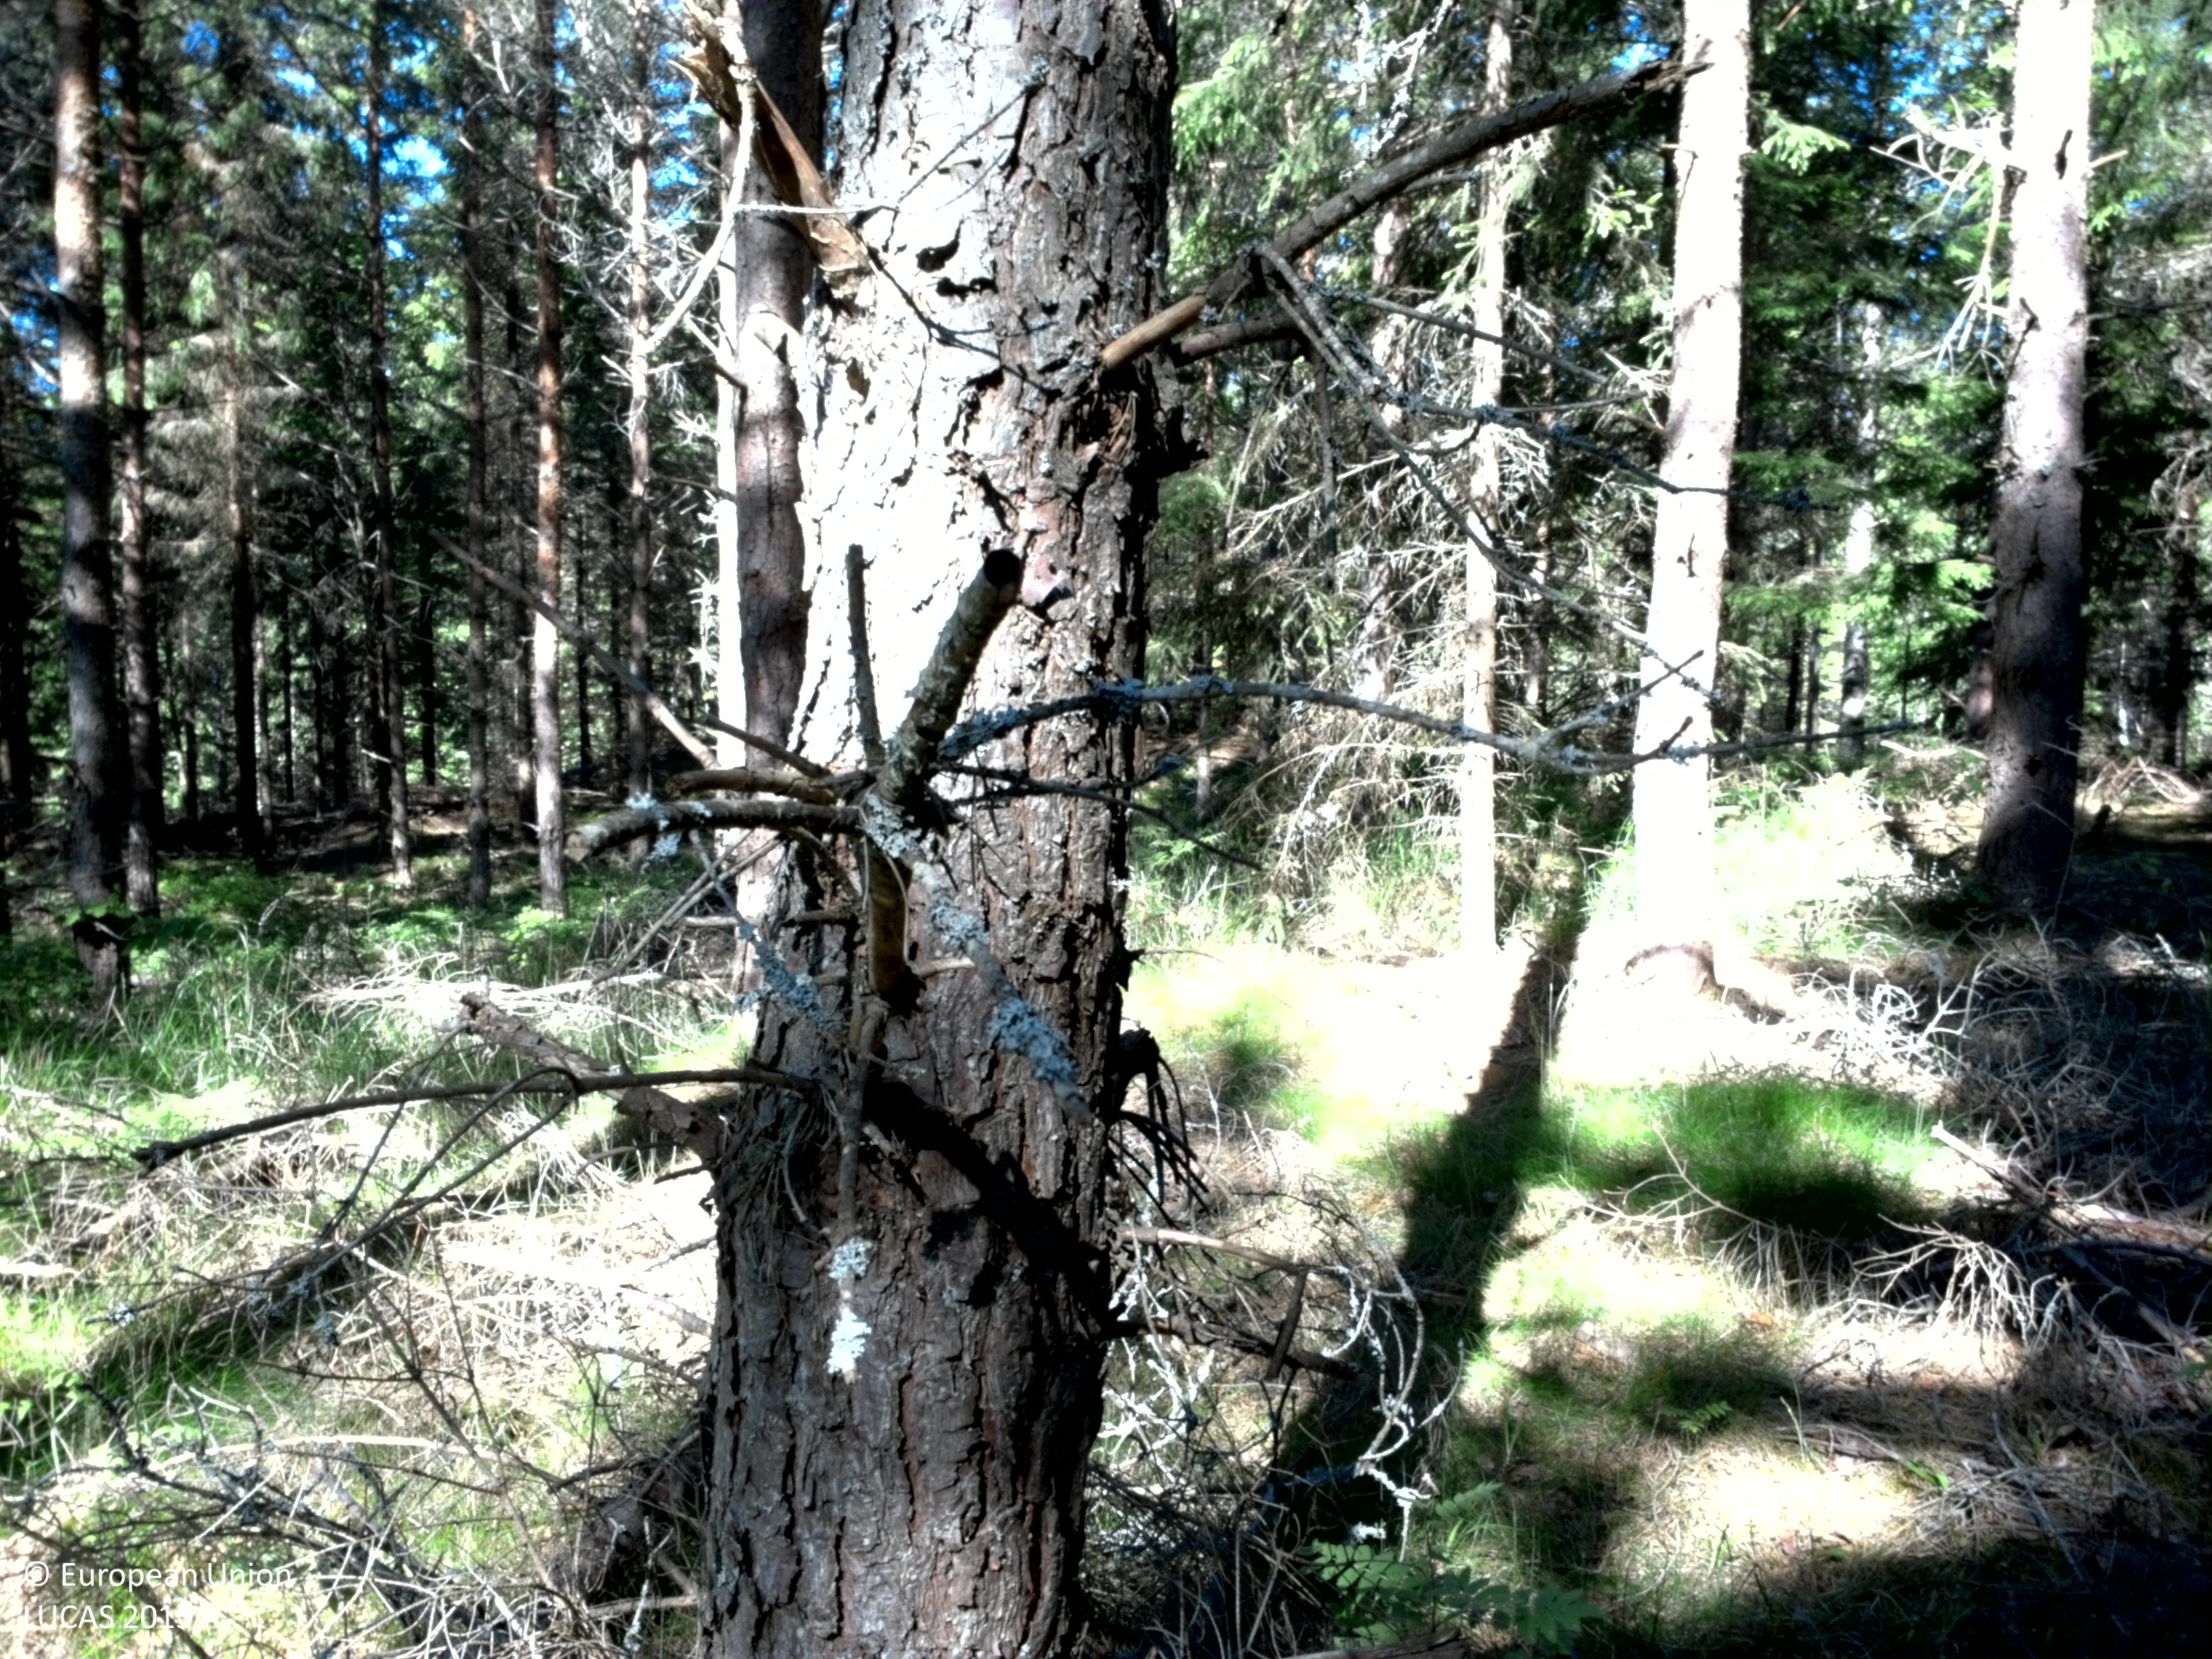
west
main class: Woodland
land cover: Other coniferous woodland
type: boreal forest
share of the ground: 25 - 50 %
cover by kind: coniferous forest trees 50 %, shrubs 25 %, herbaceous plants 10 %, lichens and mosses 10 %, broadleaved forest trees 5 %
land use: Forestry
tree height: > 5 m
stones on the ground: 10 - 25 %
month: June
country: SE
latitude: 58.6850
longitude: 14.4953
